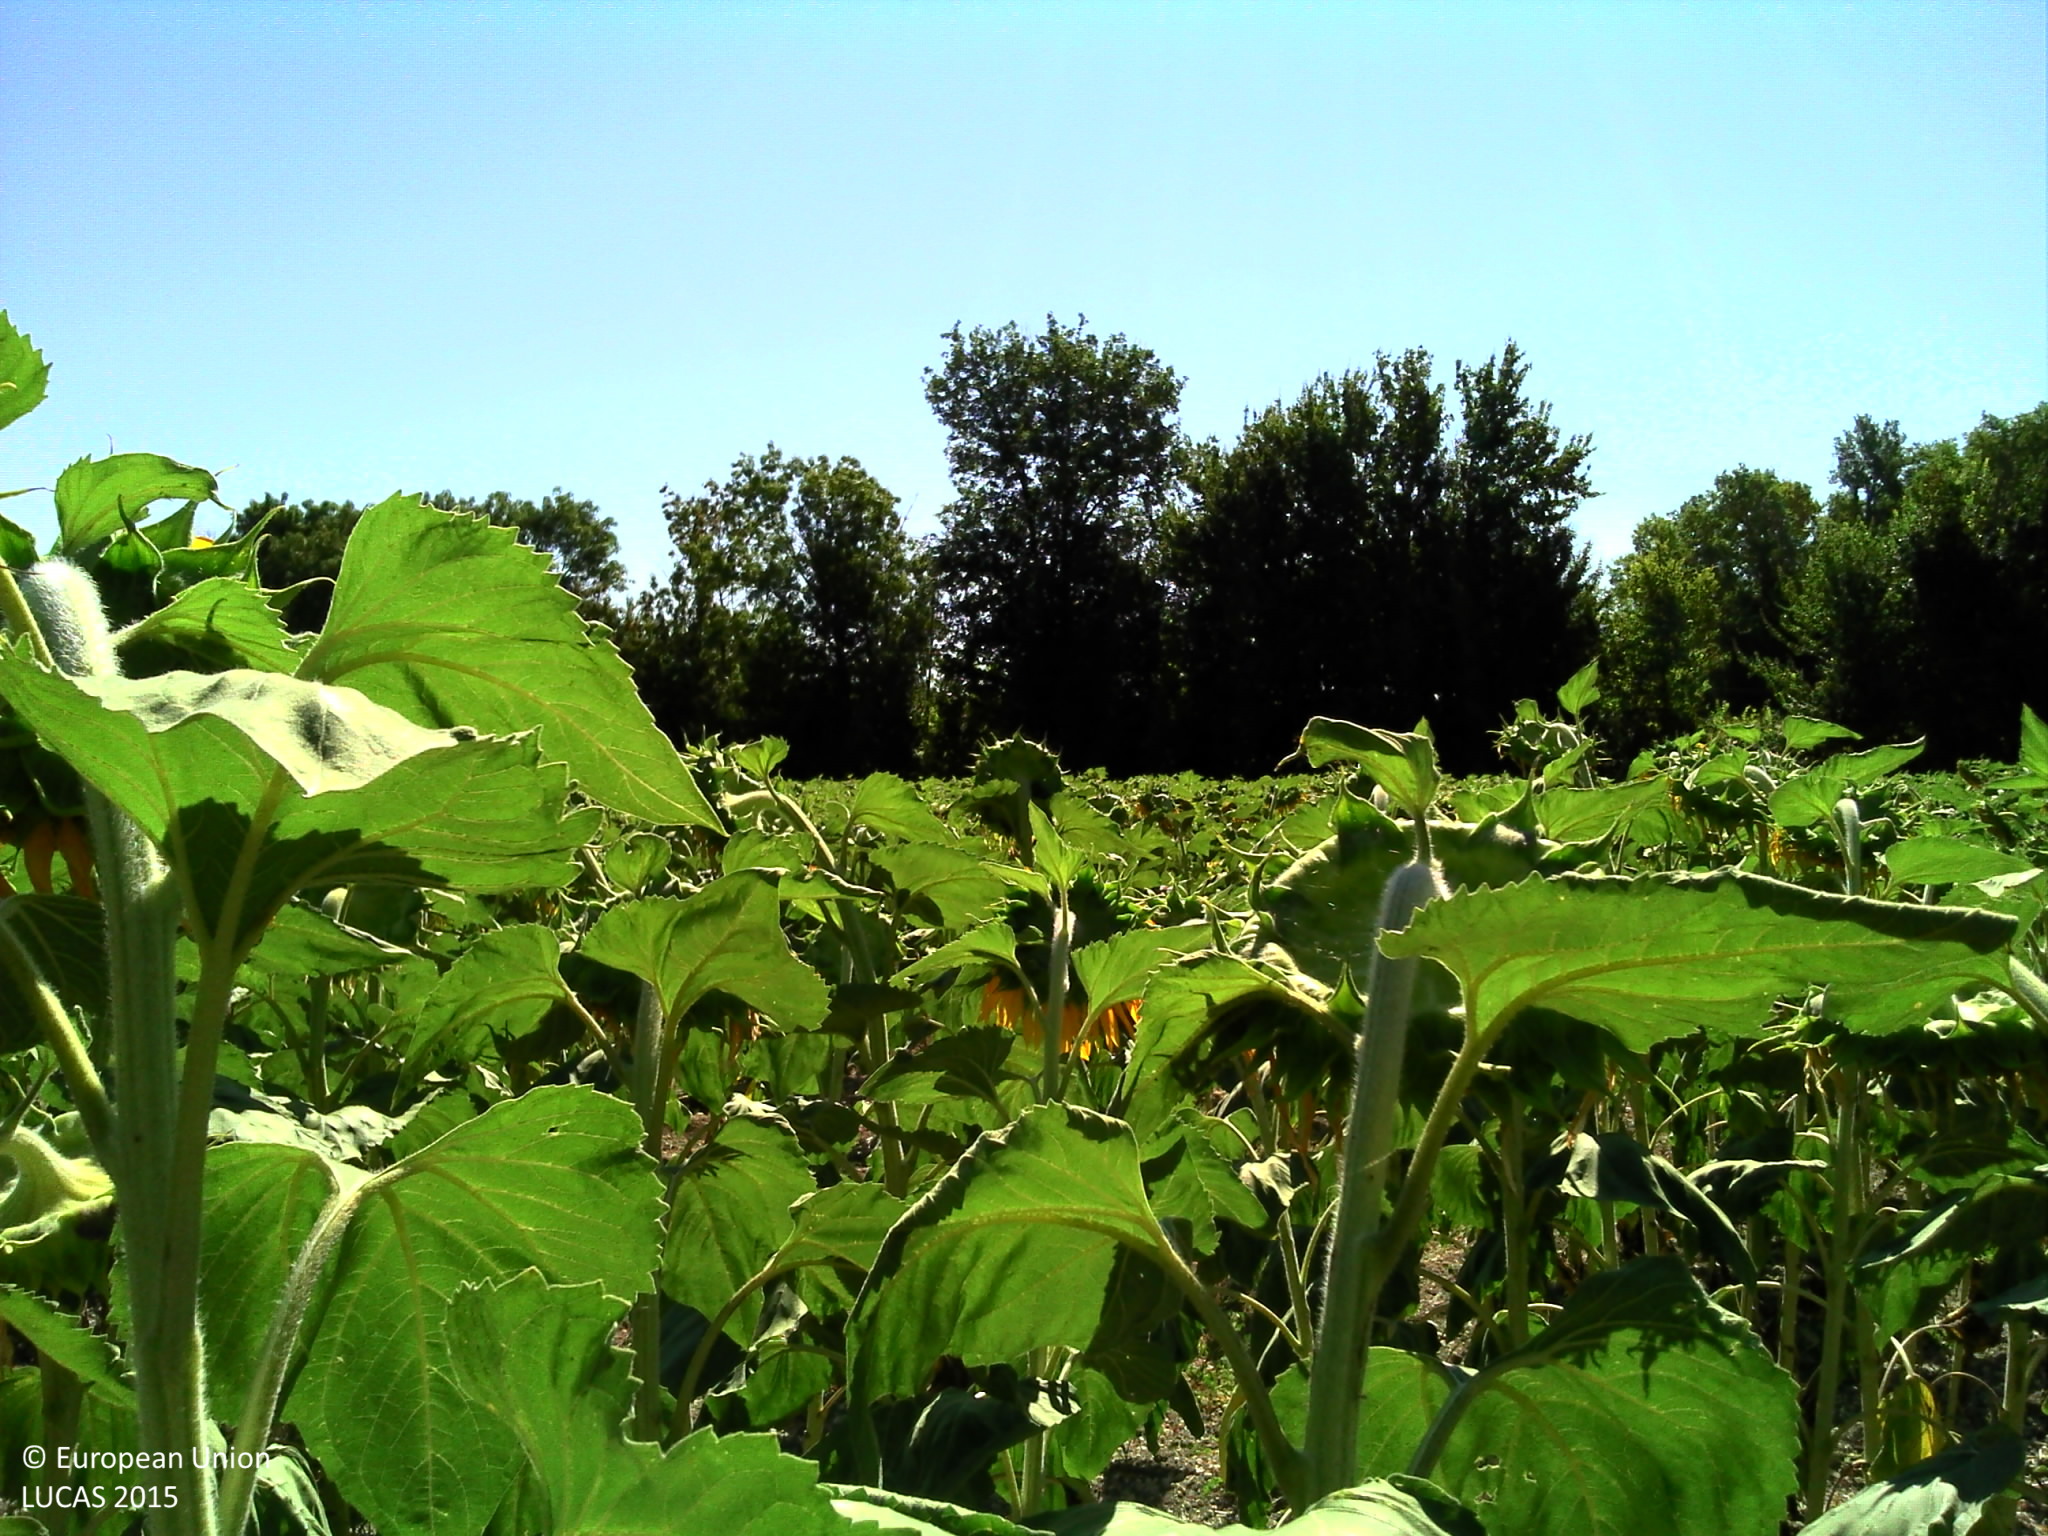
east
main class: Cropland
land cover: Sunflower
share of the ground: 50 - 75 %
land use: Agriculture (excluding fallow land and kitchen gardens)
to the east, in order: Sunflower; Abandoned hedges; Sunflower; Ditches and canals; Electric lines; Grass margins; Paved roads, cycling and walking lanes; Grass margins; Ditches and canals; Durum wheat
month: July
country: FR
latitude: 44.7514
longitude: 0.5301
